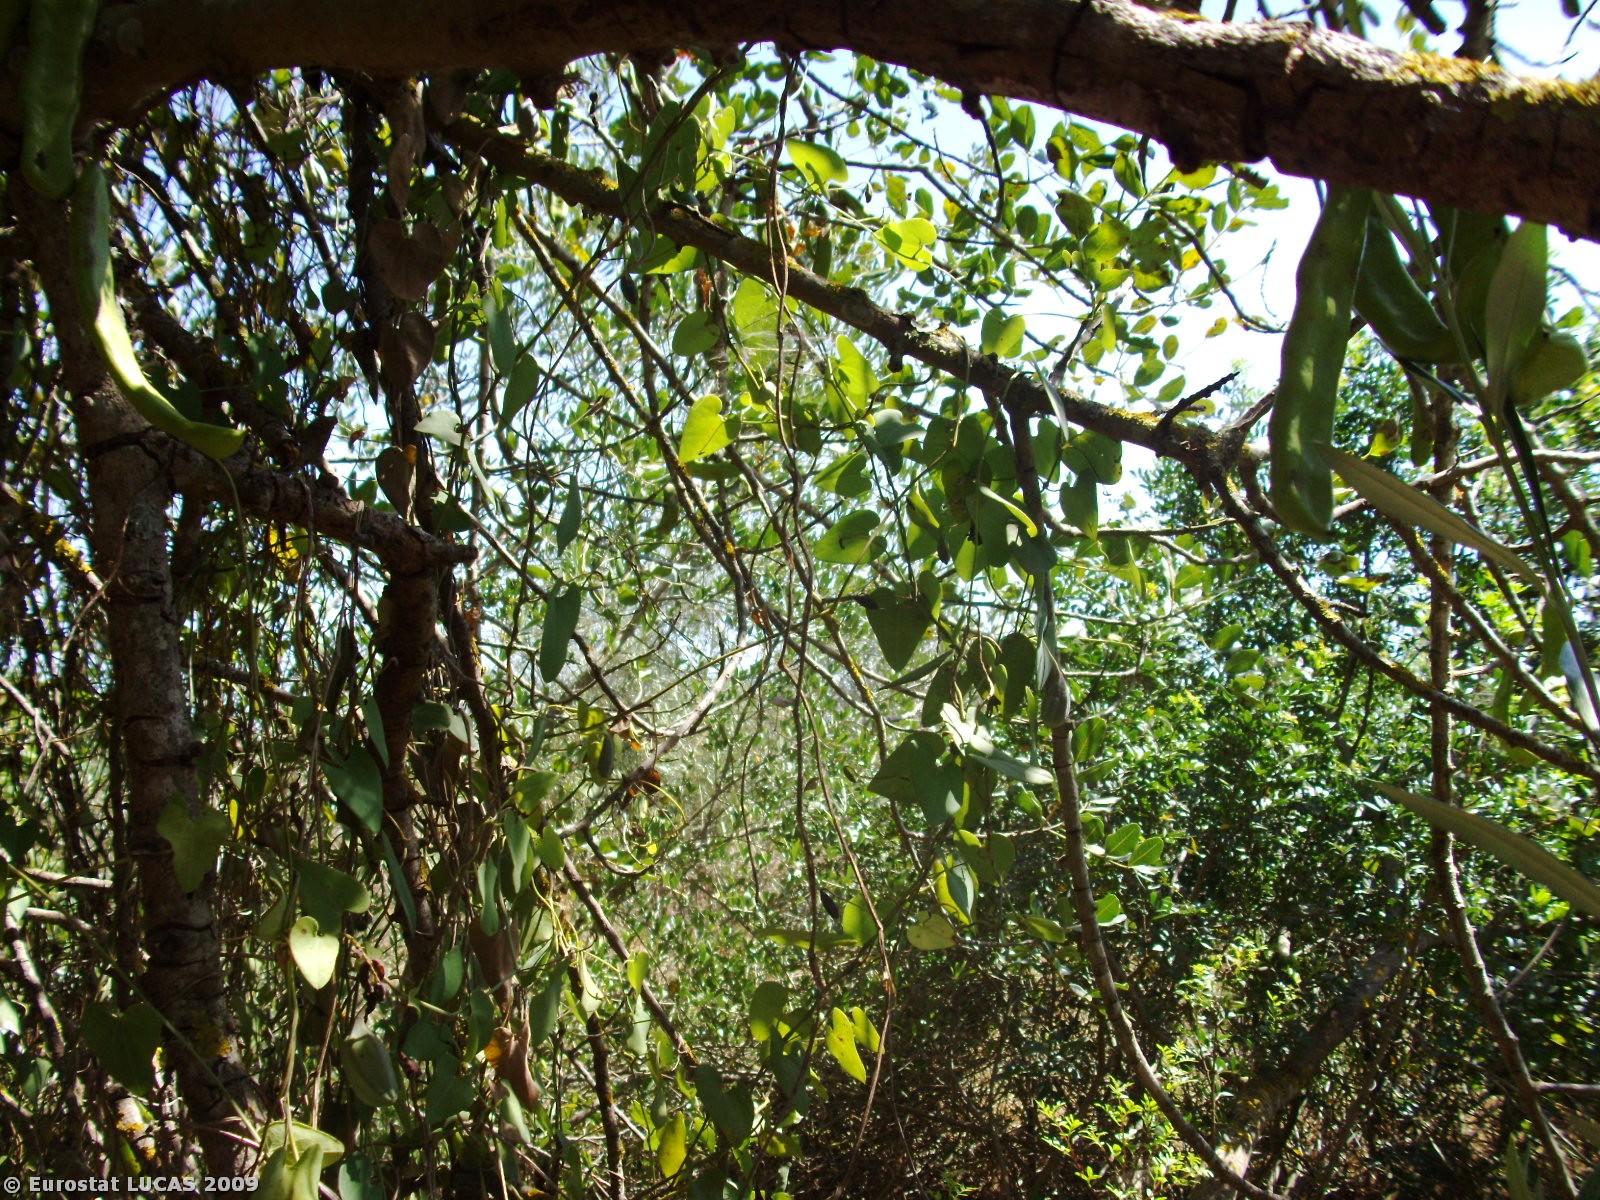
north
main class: Cropland
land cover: Permanent industrial crops
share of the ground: 25 - 50 %
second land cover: Spontaneously vegetated surfaces
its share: 50 - 75 %
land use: Agriculture (excluding fallow land and kitchen gardens)
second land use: Unused
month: May
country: PT
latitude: 37.1999
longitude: -8.2838
